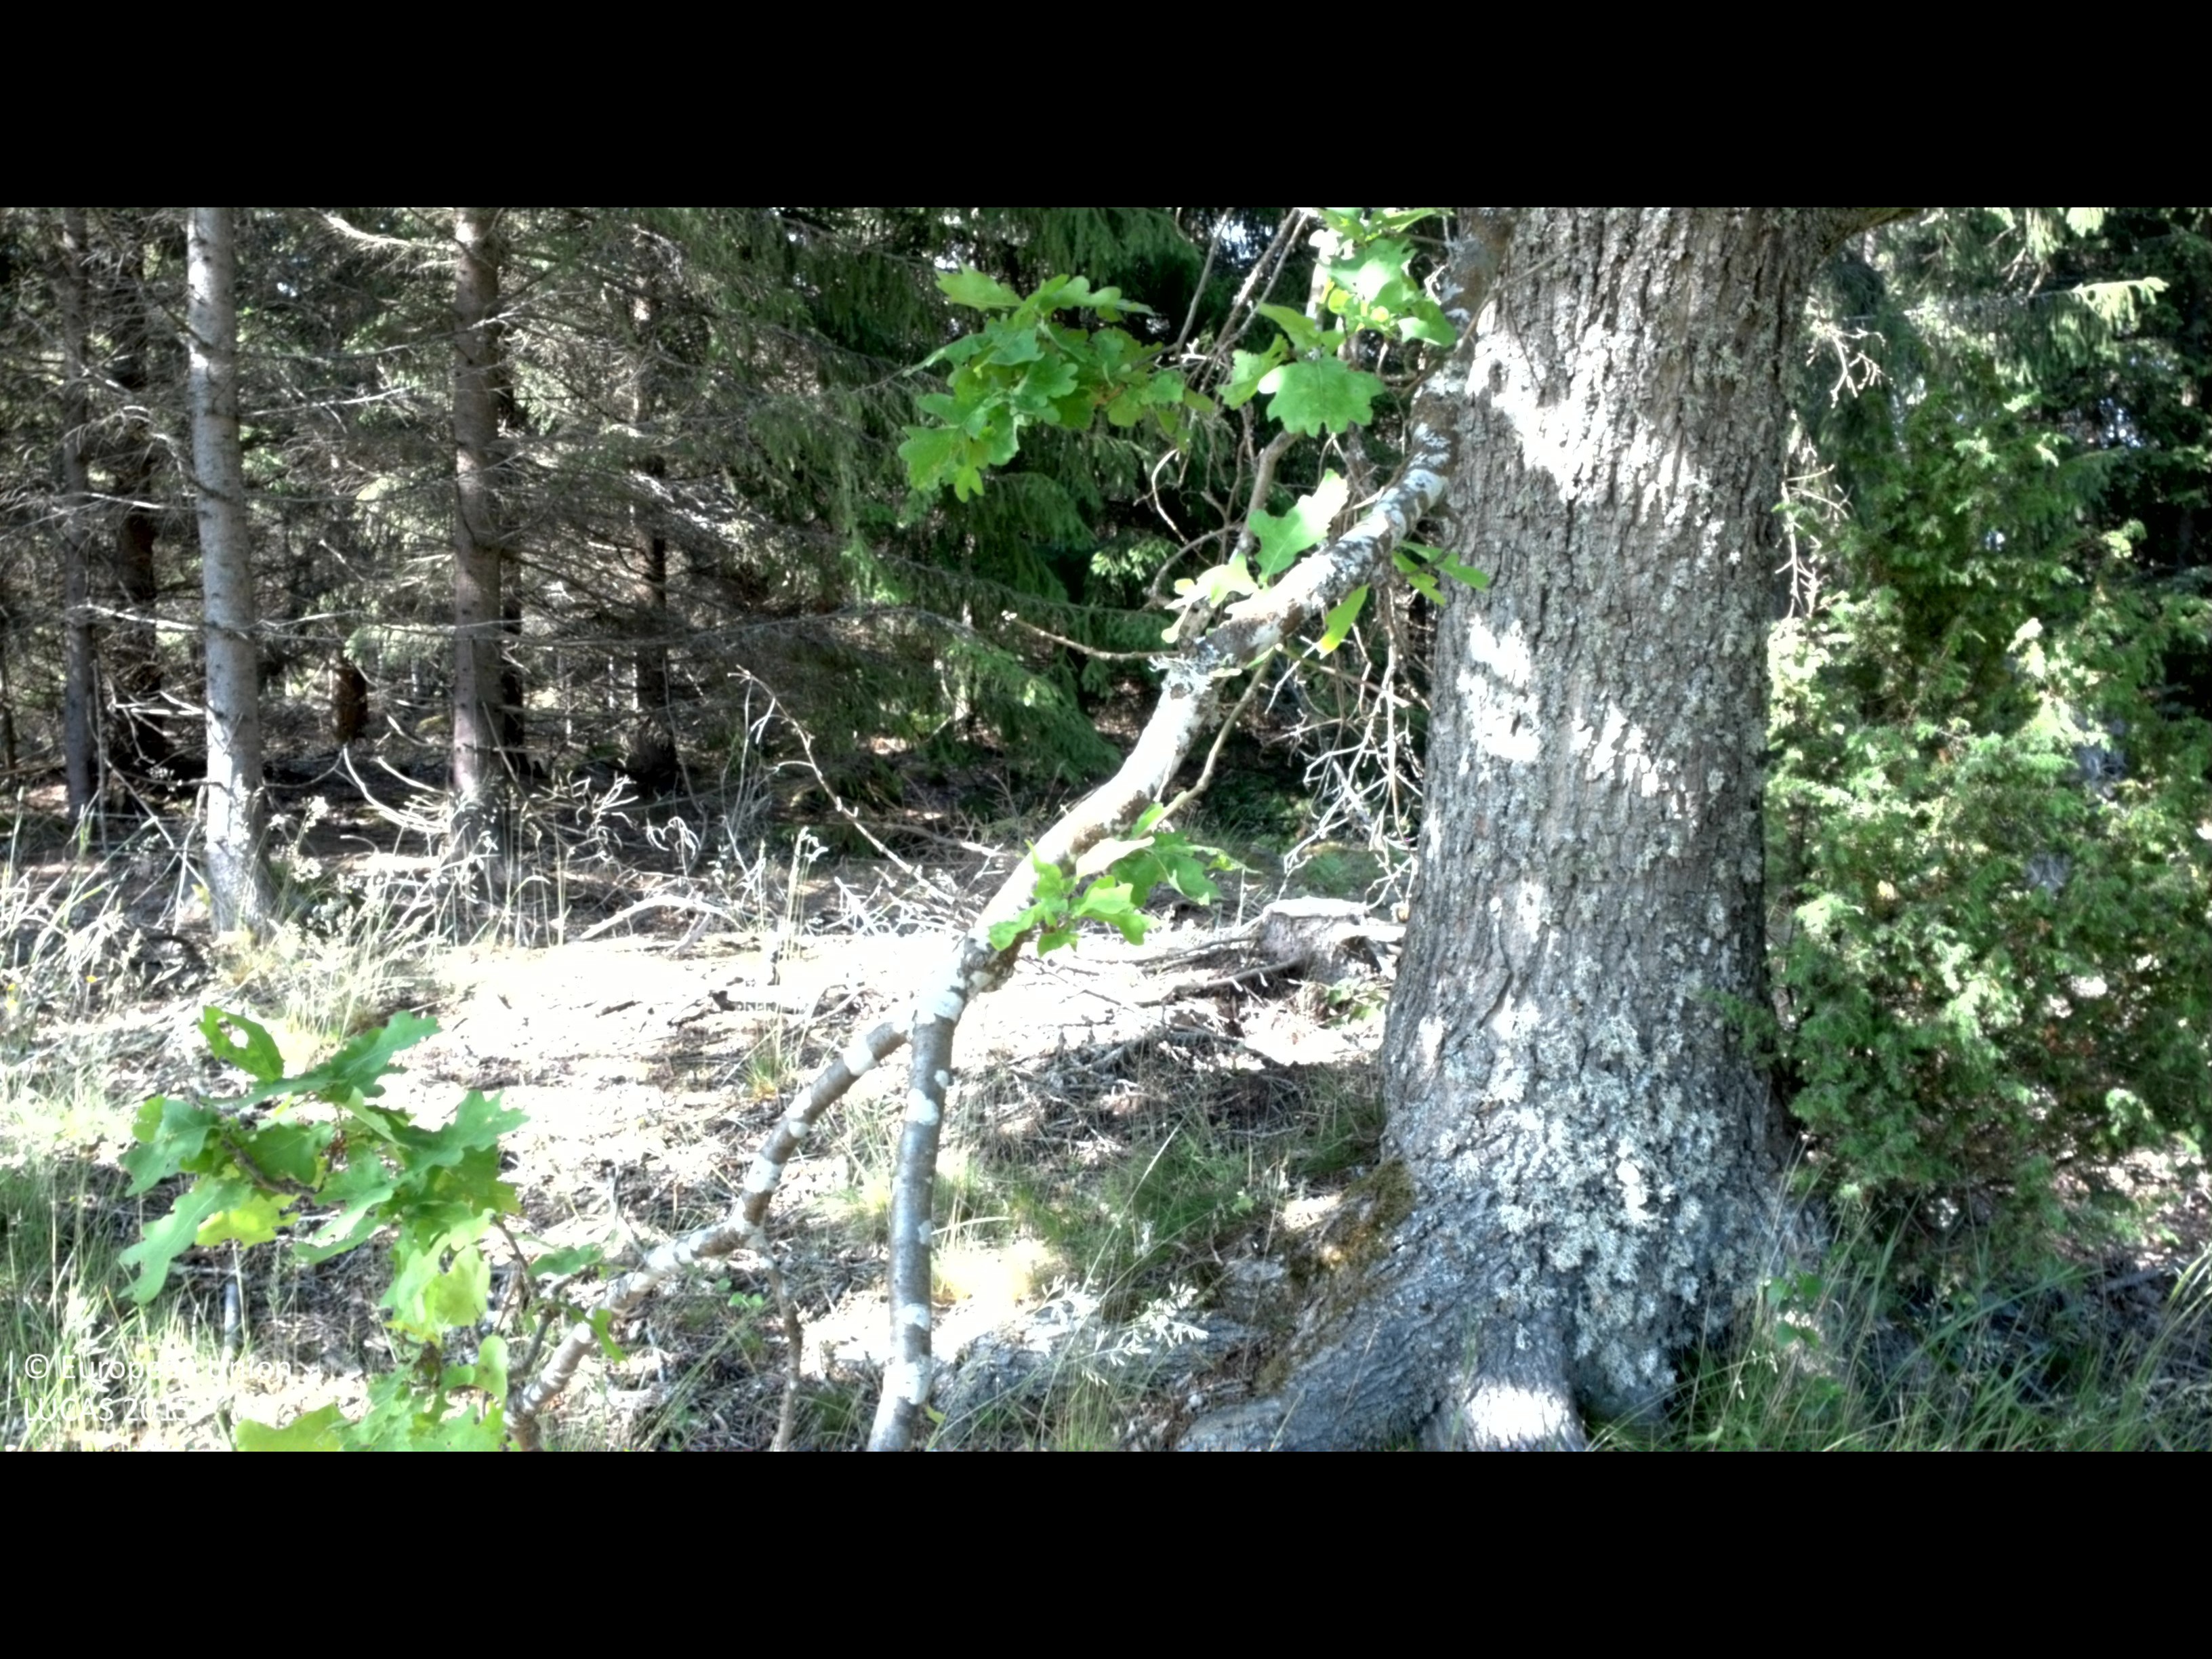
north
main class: Woodland
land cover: Spruce dominated mixed woodland
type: boreal forest
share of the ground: > 75 %
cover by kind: coniferous forest trees 65 %, broadleaved forest trees 25 %, herbaceous plants 5 %, unconsolidated bare surface 5 %
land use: Forestry
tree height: > 5 m
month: June
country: SE
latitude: 58.0366
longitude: 16.6541
